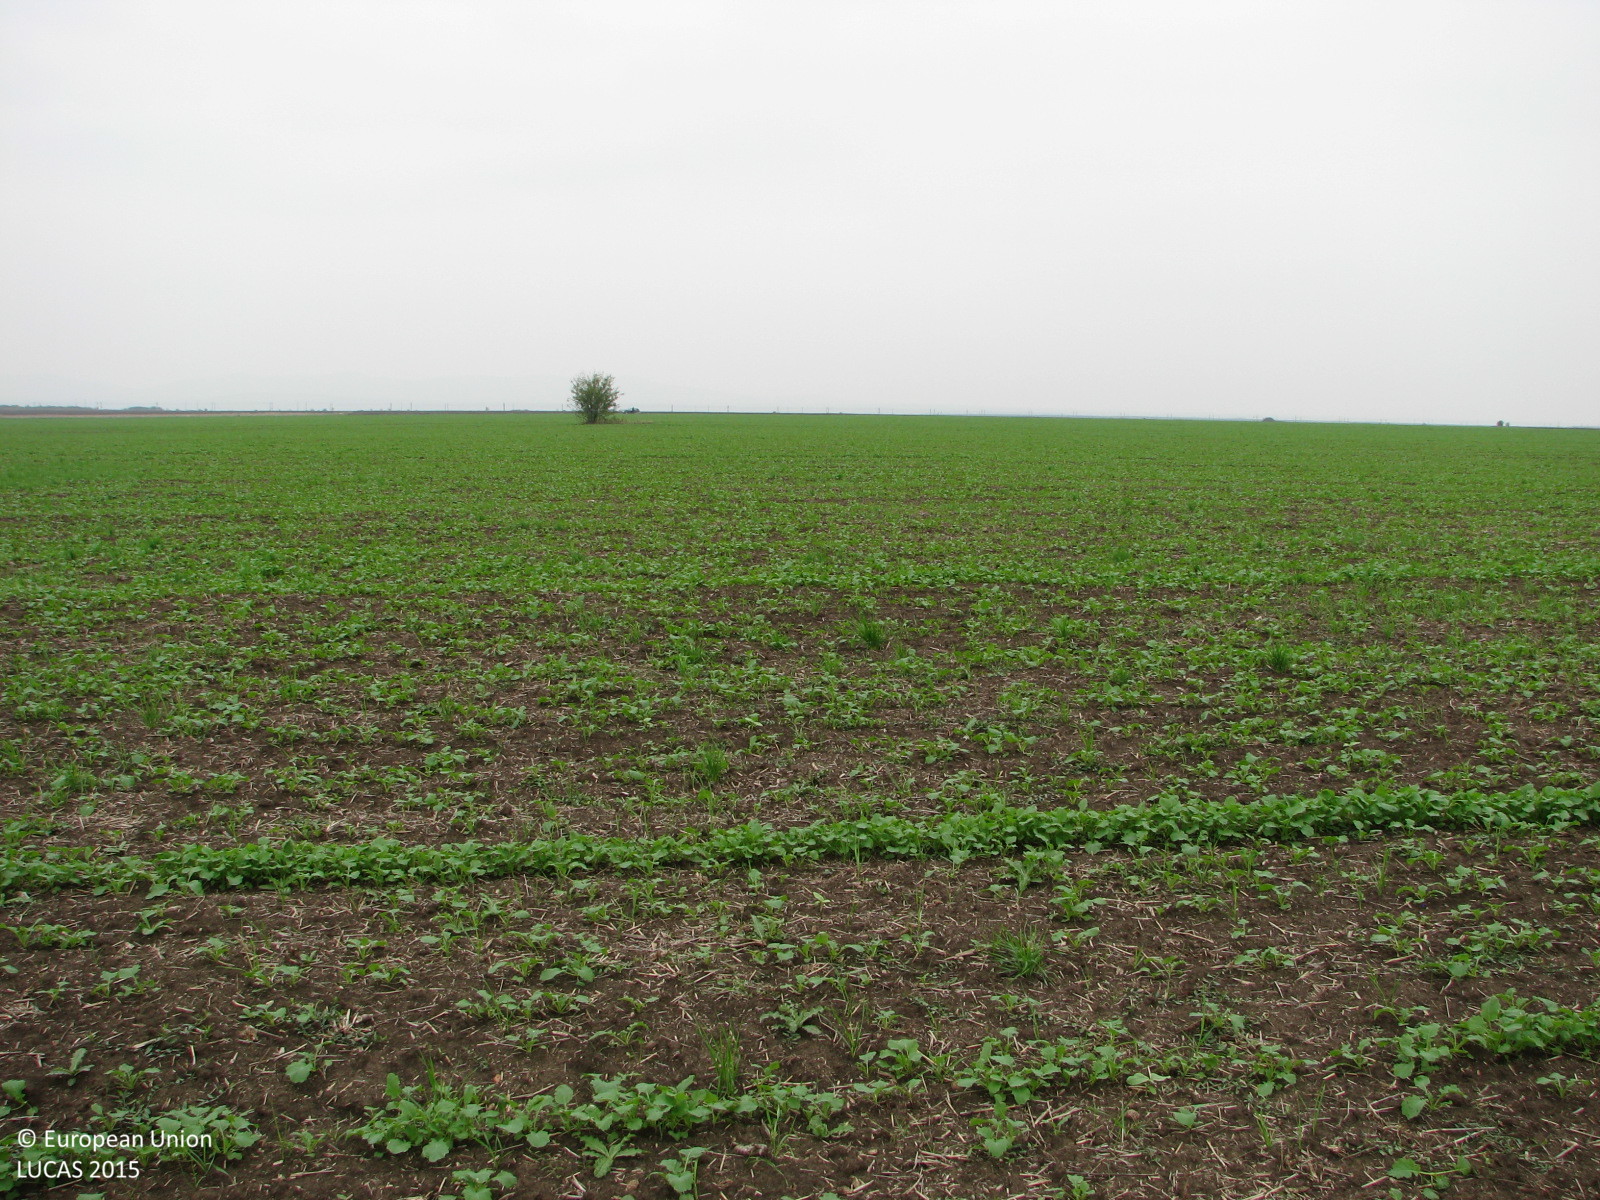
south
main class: Cropland
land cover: Rape and turnip rape
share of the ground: 25 - 50 %
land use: Agriculture (excluding fallow land and kitchen gardens)
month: October
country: BG
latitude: 42.6055
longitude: 26.6625
